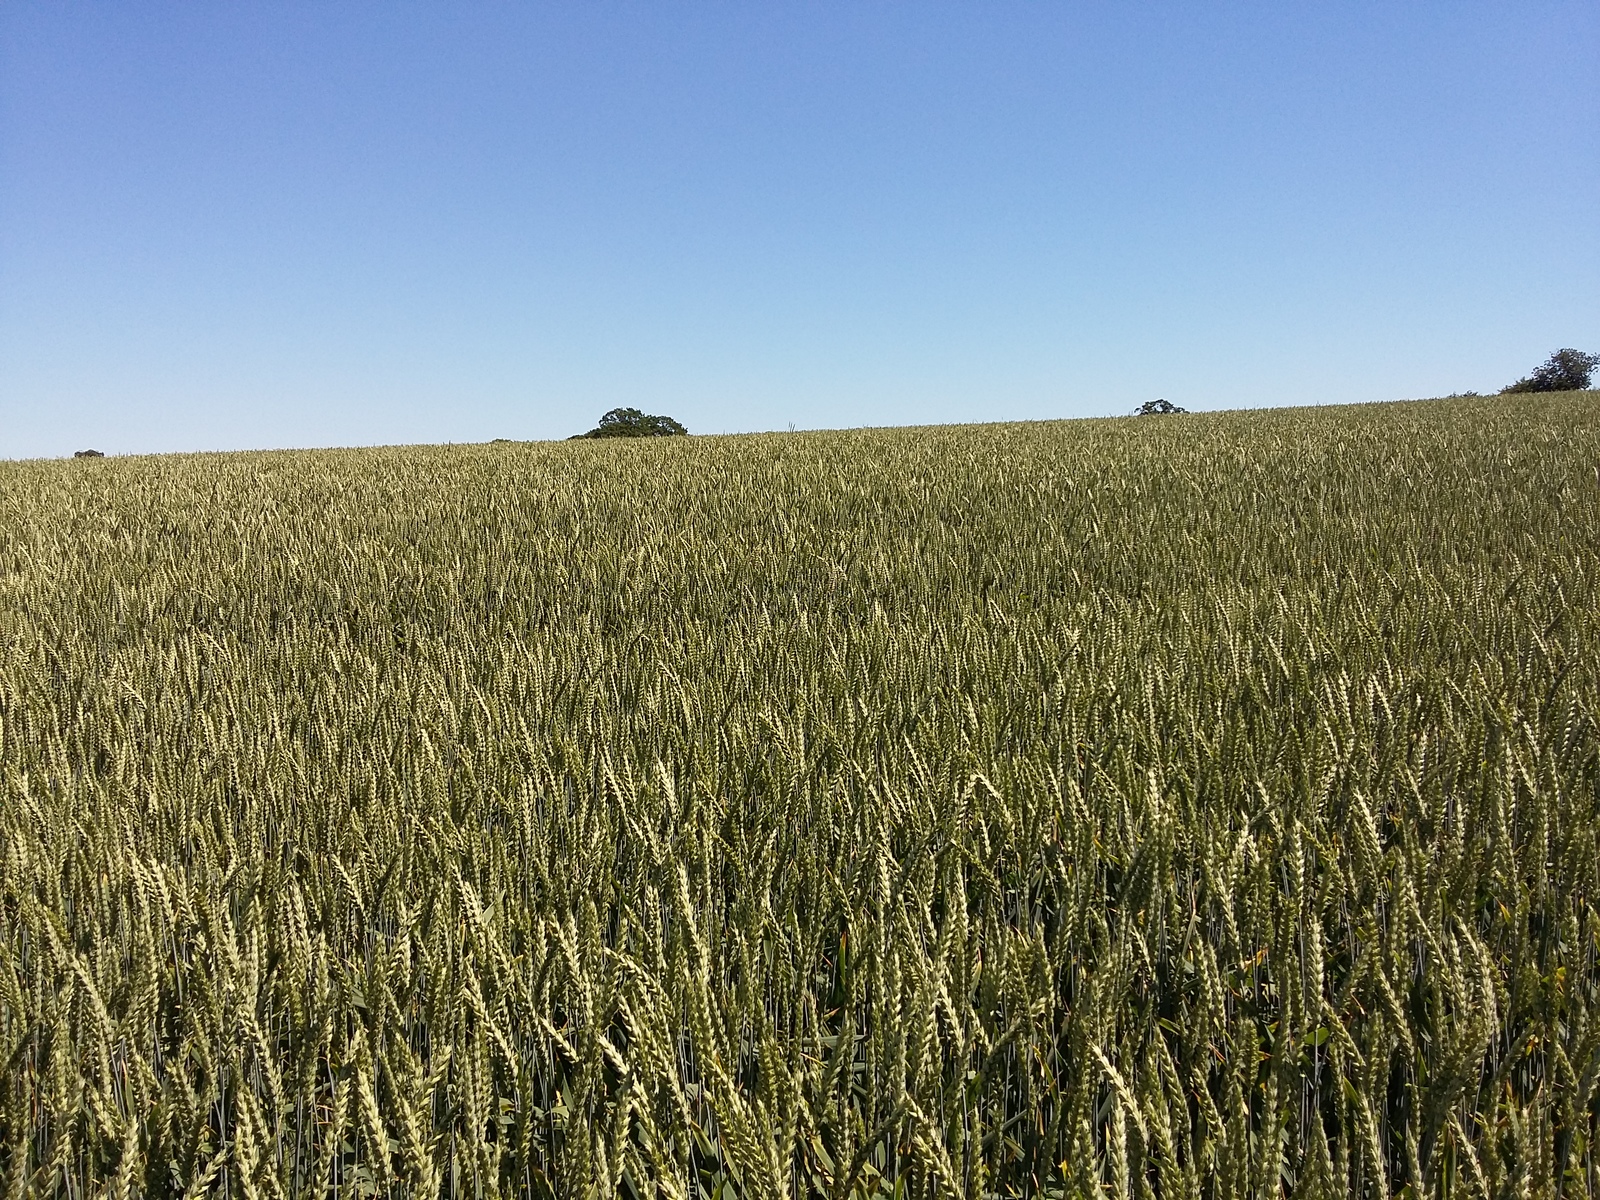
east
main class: Cropland
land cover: Common wheat
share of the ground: > 75 %
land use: Agriculture (excluding fallow land and kitchen gardens)
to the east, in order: Common wheat; Grass margins; Fences; Broadleaved woodland; Fences; Shruby margins; Maize; Common wheat
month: July
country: DK
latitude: 55.1290
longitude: 12.0217
